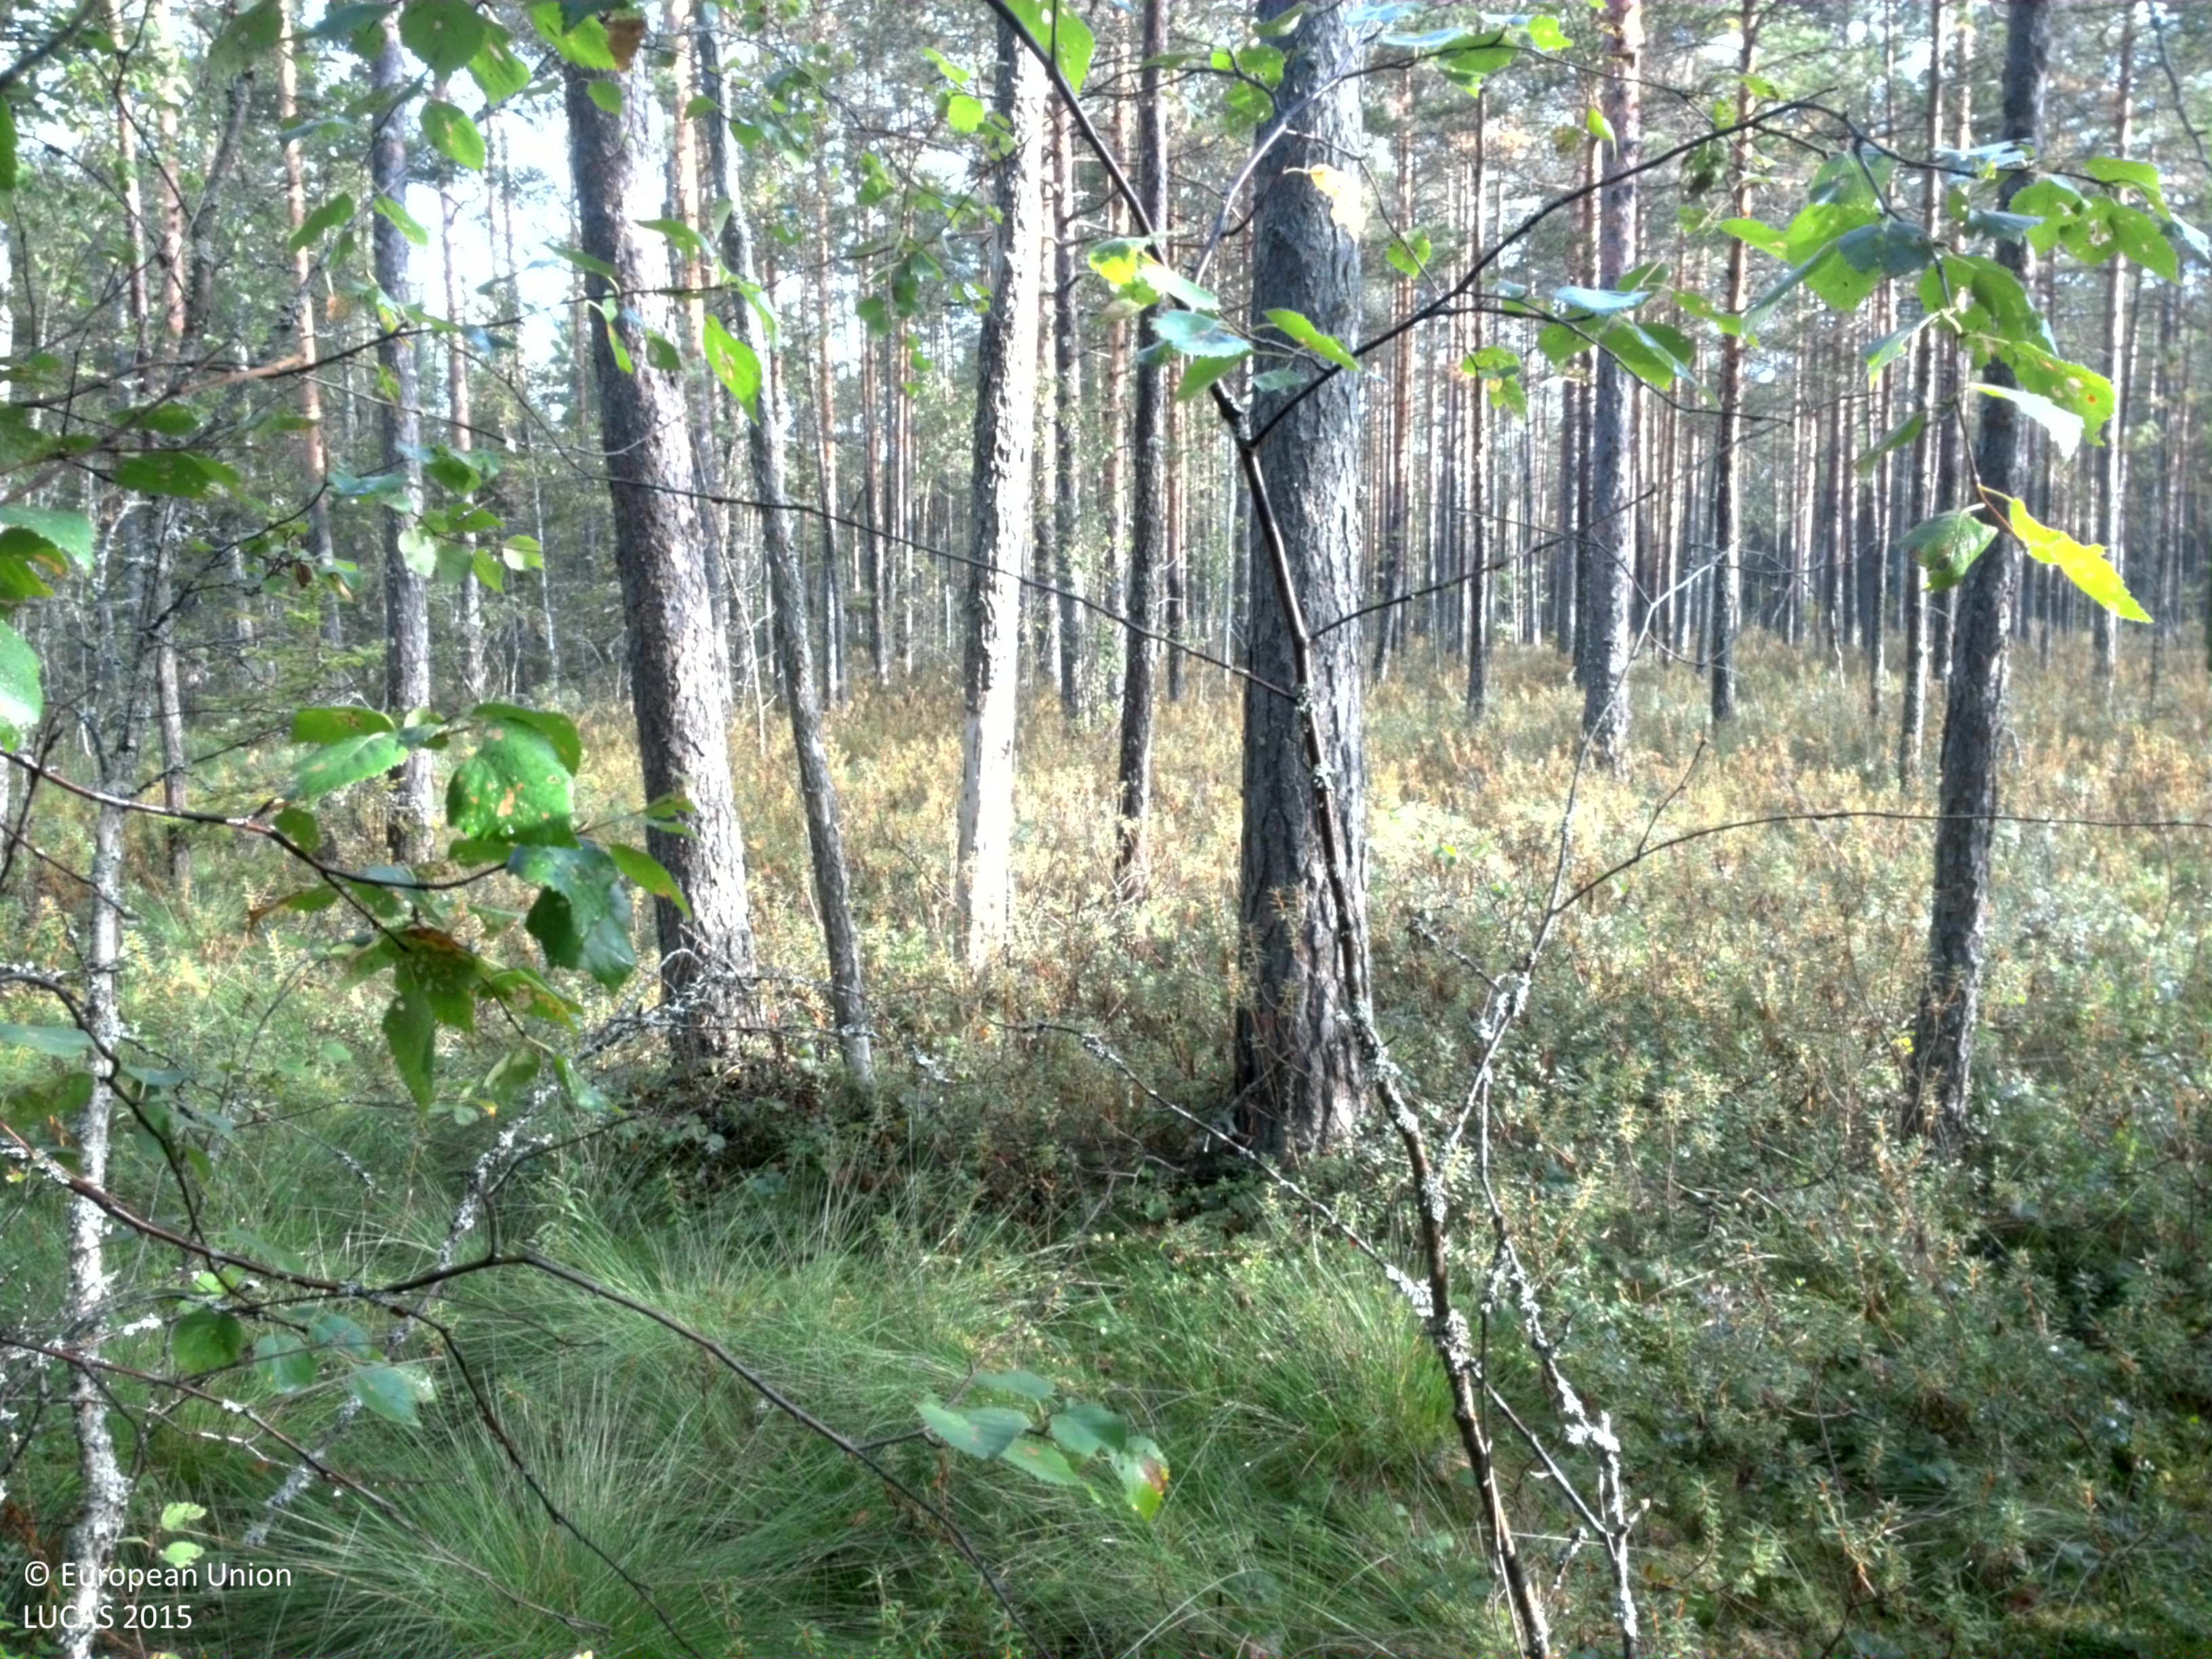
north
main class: Woodland
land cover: Pine dominated mixed woodland
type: boreal forest
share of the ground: 50 - 75 %
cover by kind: coniferous forest trees 45 %, broadleaved forest trees 20 %, shrubs 20 %, lichens and mosses 15 %
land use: Forestry
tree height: > 5 m
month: August
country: SE
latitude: 59.8165
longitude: 15.6071
